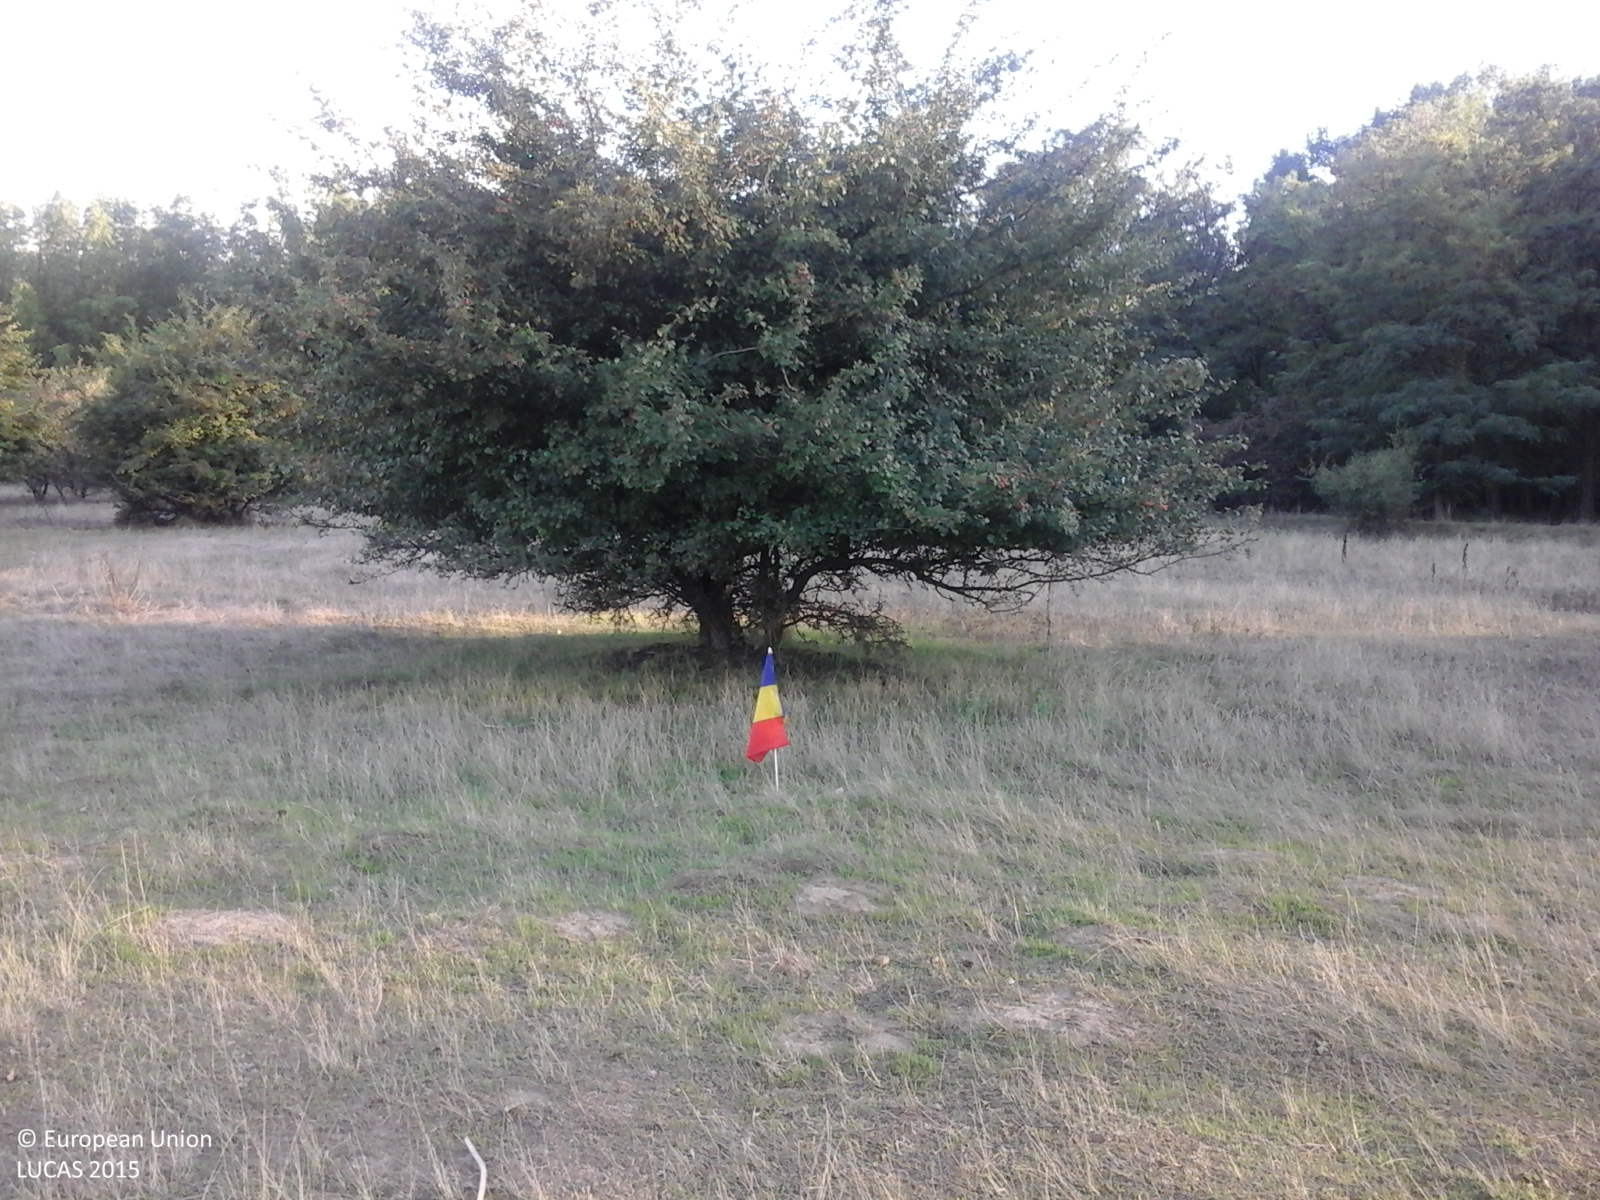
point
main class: Grassland
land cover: Grassland with sparse tree/shrub cover
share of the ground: > 75 %
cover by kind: herbaceous plants 85 %, shrubs 10 %, broadleaved forest trees 5 %
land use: Agriculture (excluding fallow land and kitchen gardens)
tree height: < 5 m
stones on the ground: < 10 %
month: August
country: RO
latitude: 46.1422
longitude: 21.2045
